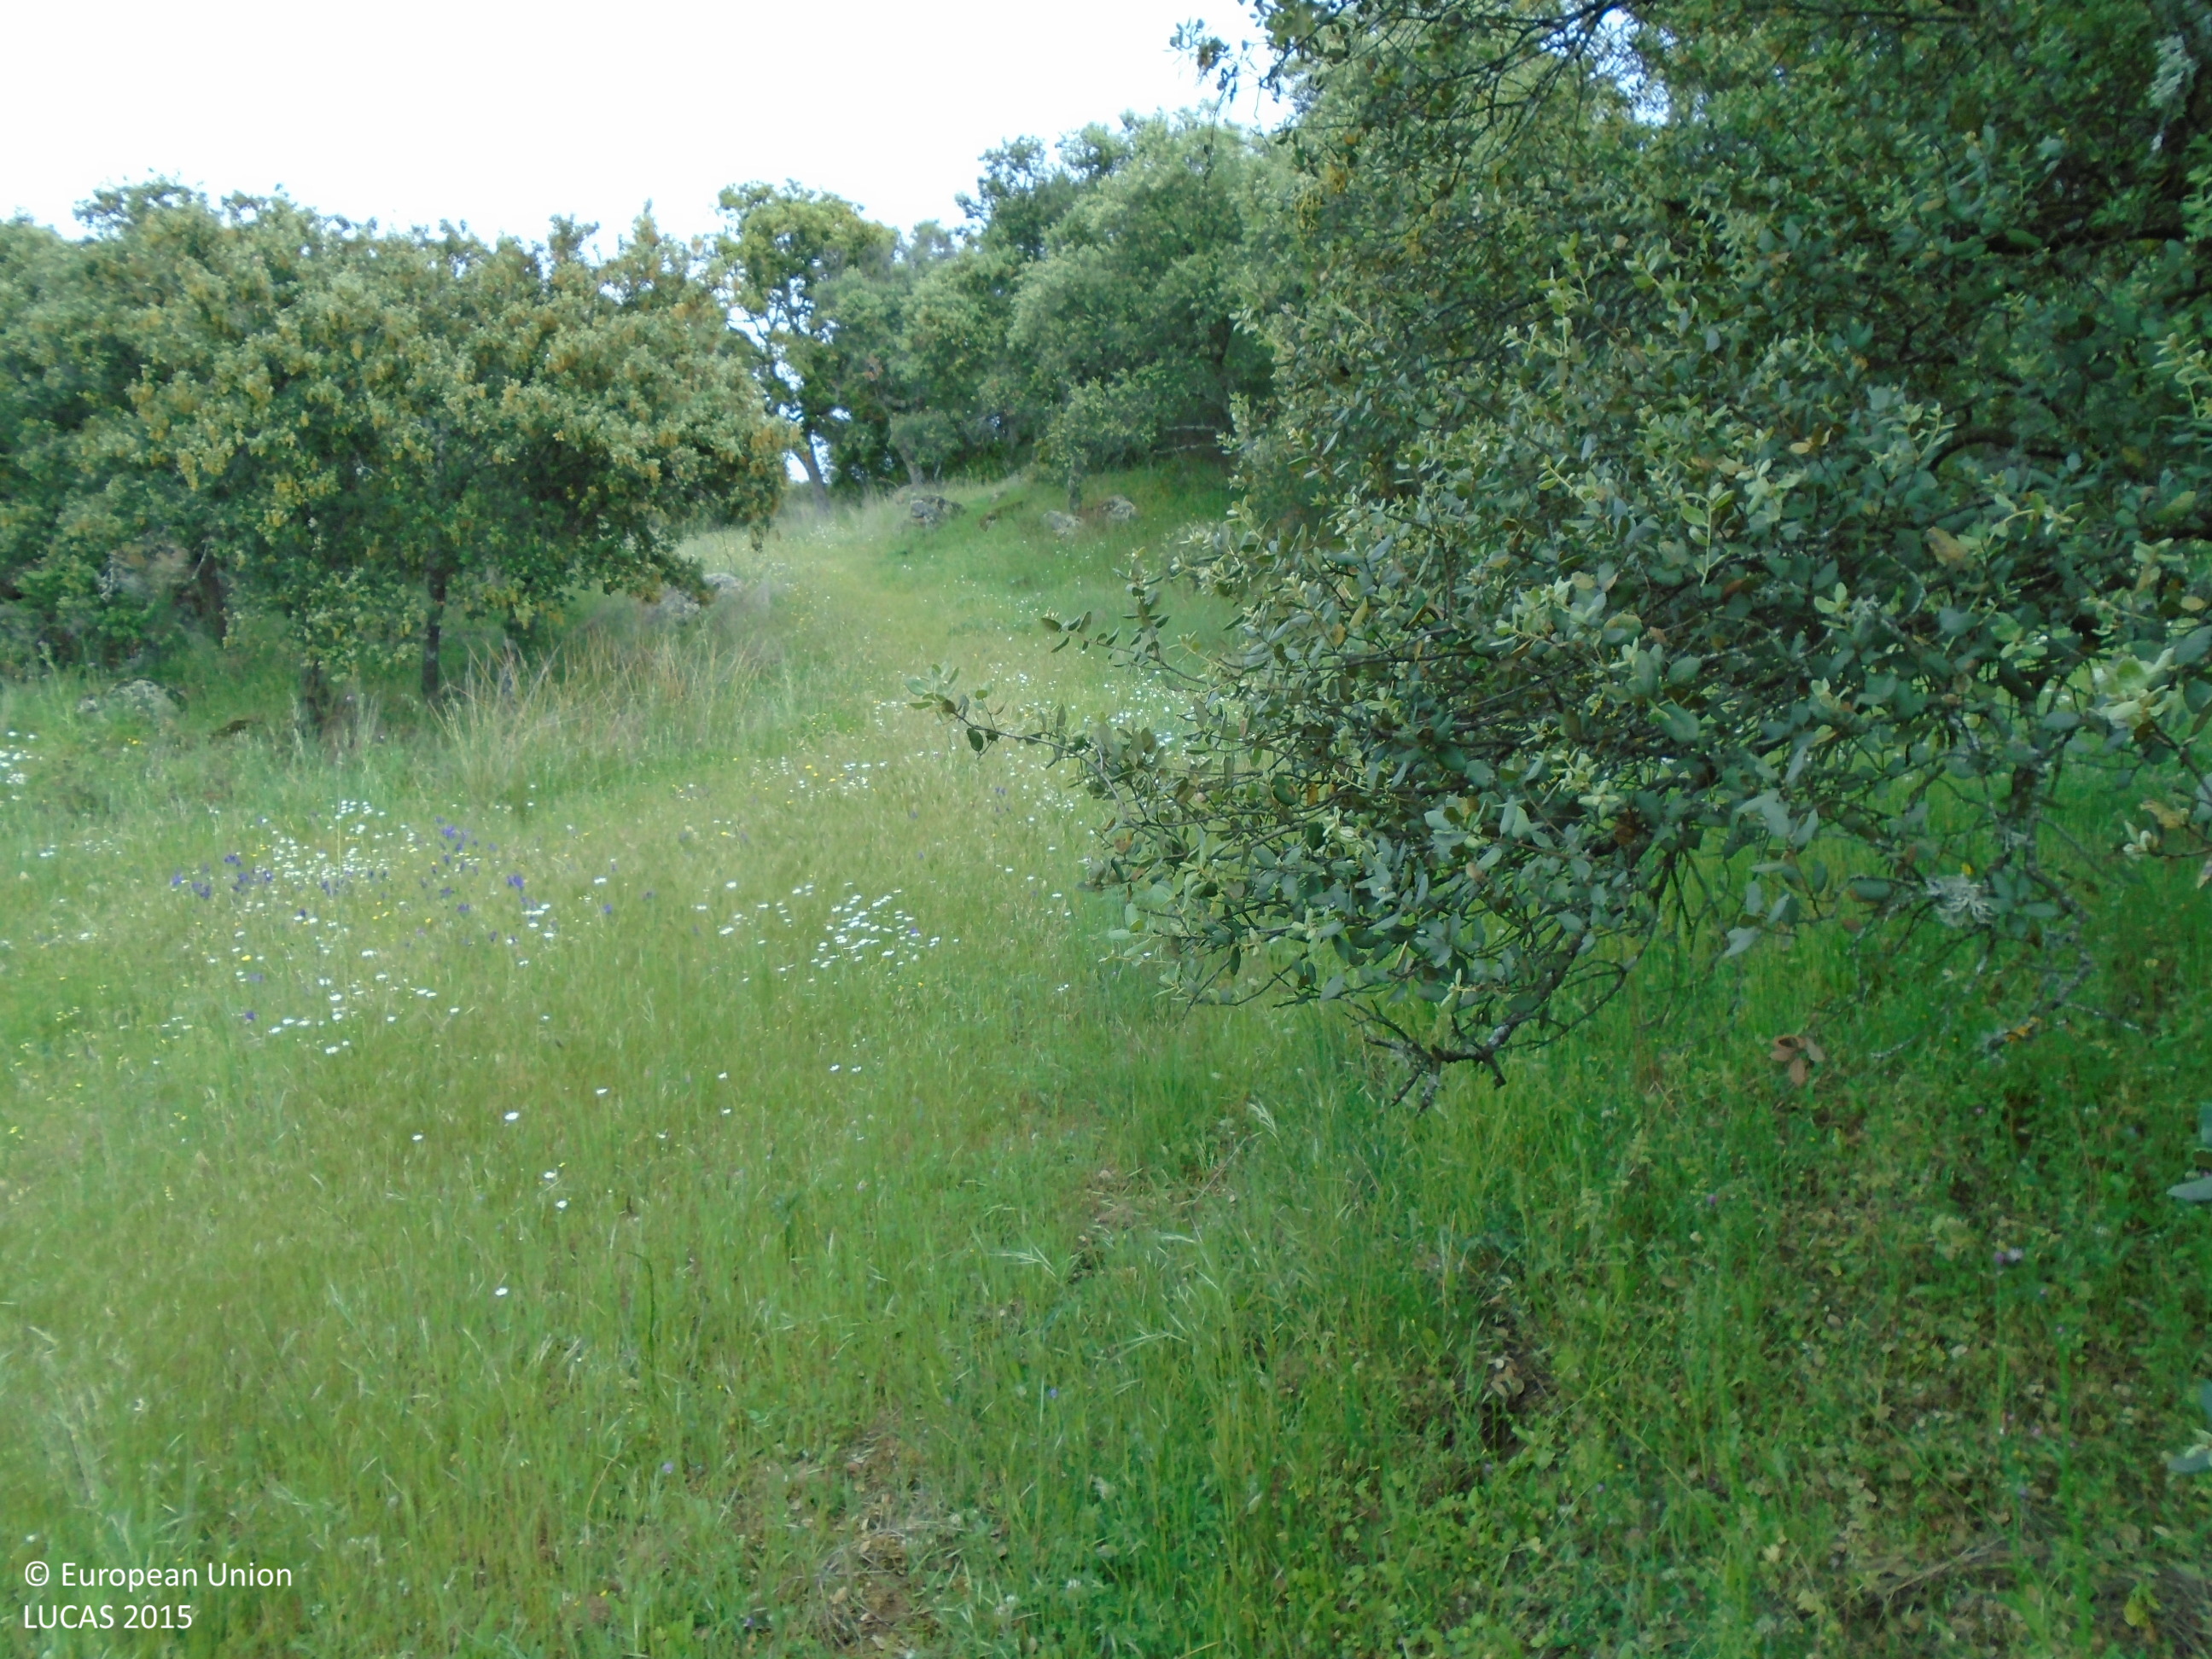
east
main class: Woodland
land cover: Broadleaved woodland
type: broadleaved evergreen forest
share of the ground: > 75 %
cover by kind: broadleaved forest trees 90 %, shrubs 5 %, herbaceous plants 5 %
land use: Semi-natural and natural areas not in use
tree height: > 5 m
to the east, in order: Broadleaved woodland; Spontaneously vegetated surfaces; Broadleaved woodland; Rock outcrops; Broadleaved woodland; Spontaneously vegetated surfaces; Rock outcrops; Grass margins; Tracks
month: May
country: ES
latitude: 39.7568
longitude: -4.7146
